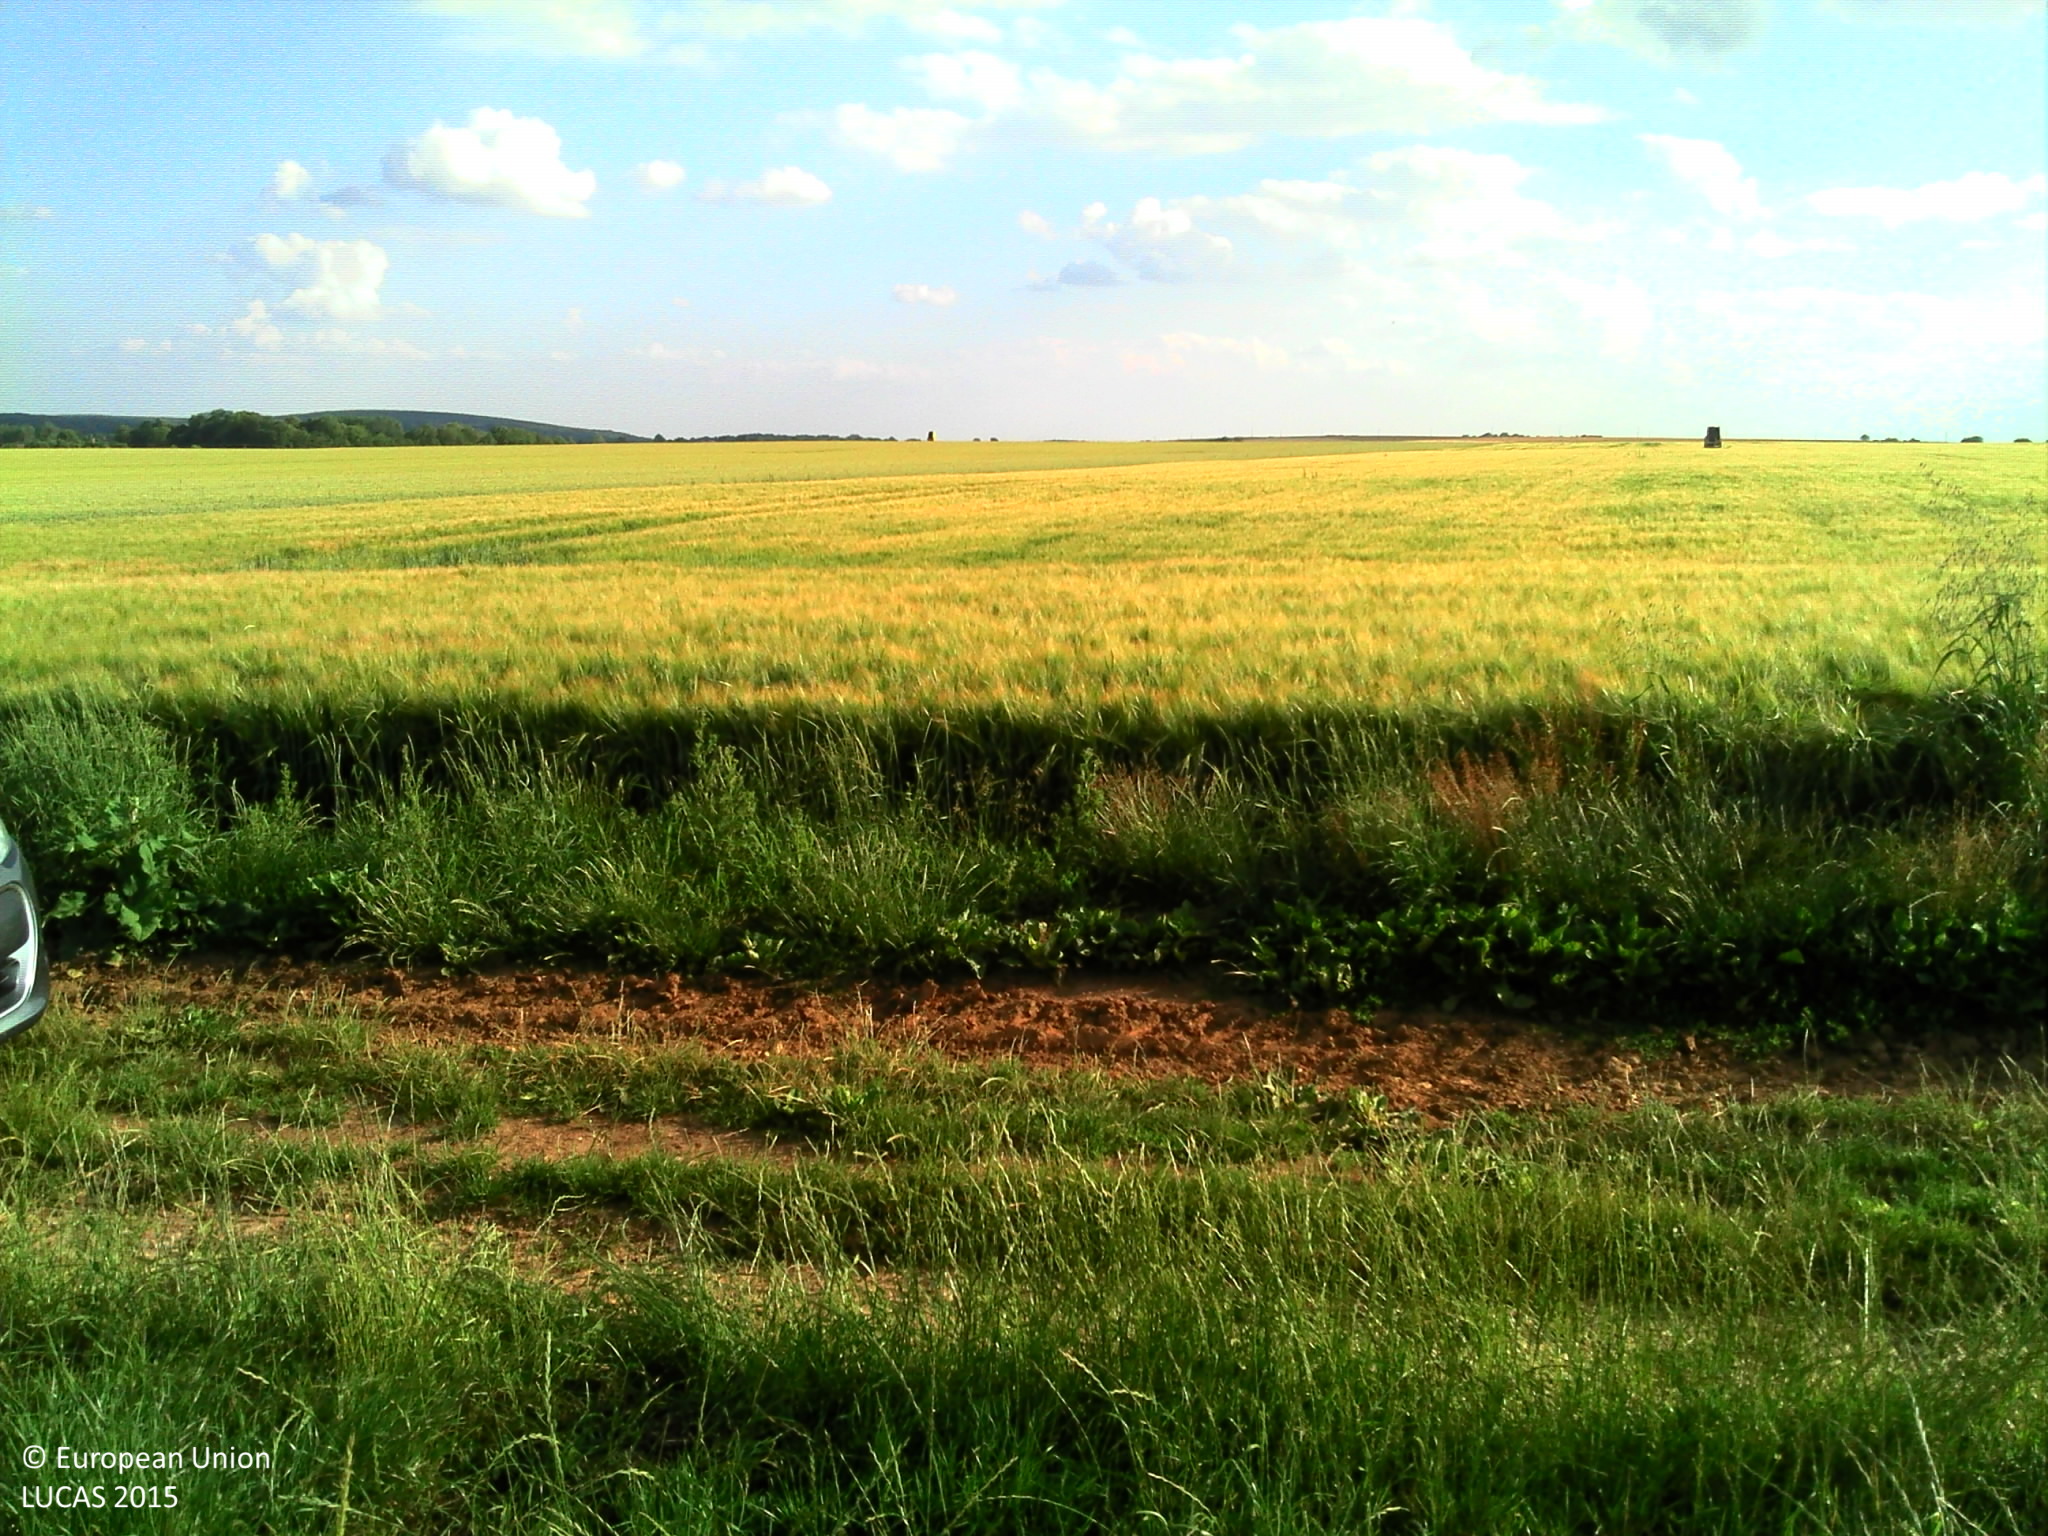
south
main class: Cropland
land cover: Common wheat
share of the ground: > 75 %
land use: Agriculture (excluding fallow land and kitchen gardens)
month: June
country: FR
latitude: 47.3944
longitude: 3.1189
